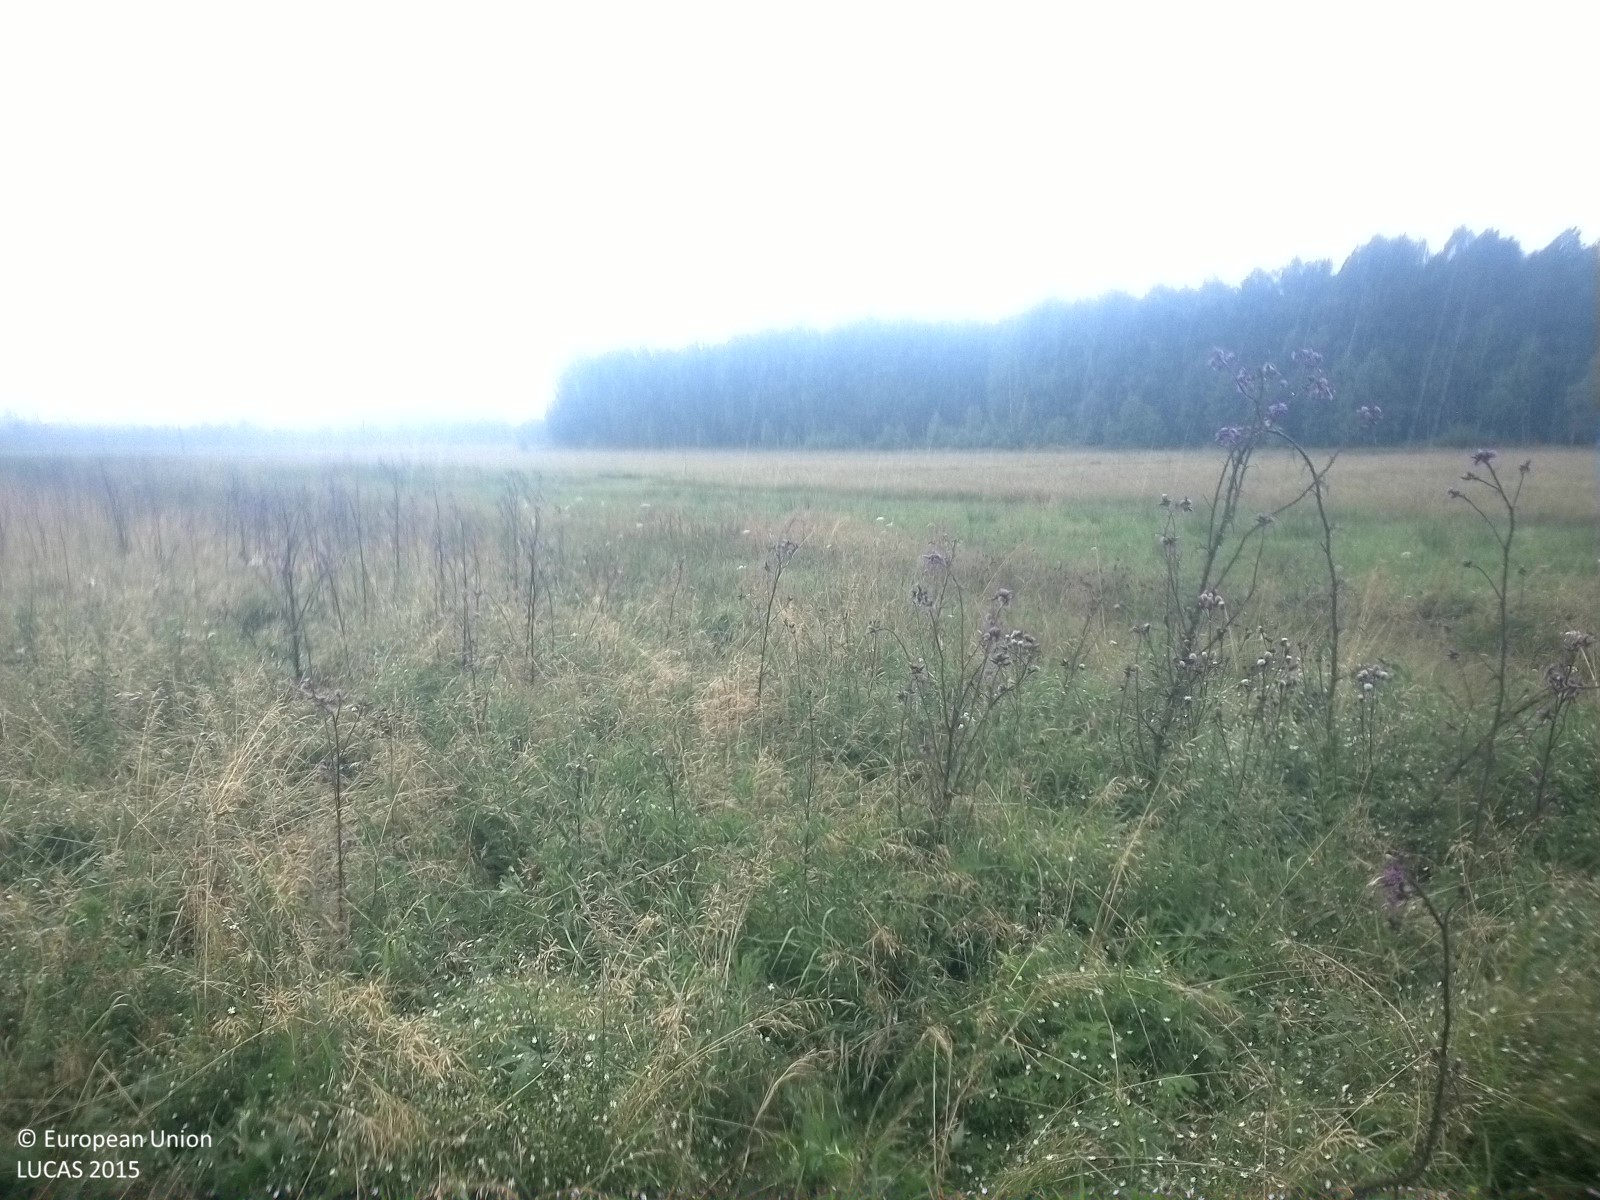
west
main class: Grassland
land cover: Spontaneously vegetated surfaces
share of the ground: > 75 %
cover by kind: herbaceous plants 100 %
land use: Agriculture (excluding fallow land and kitchen gardens)
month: July
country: SE
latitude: 58.9001
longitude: 15.0436
